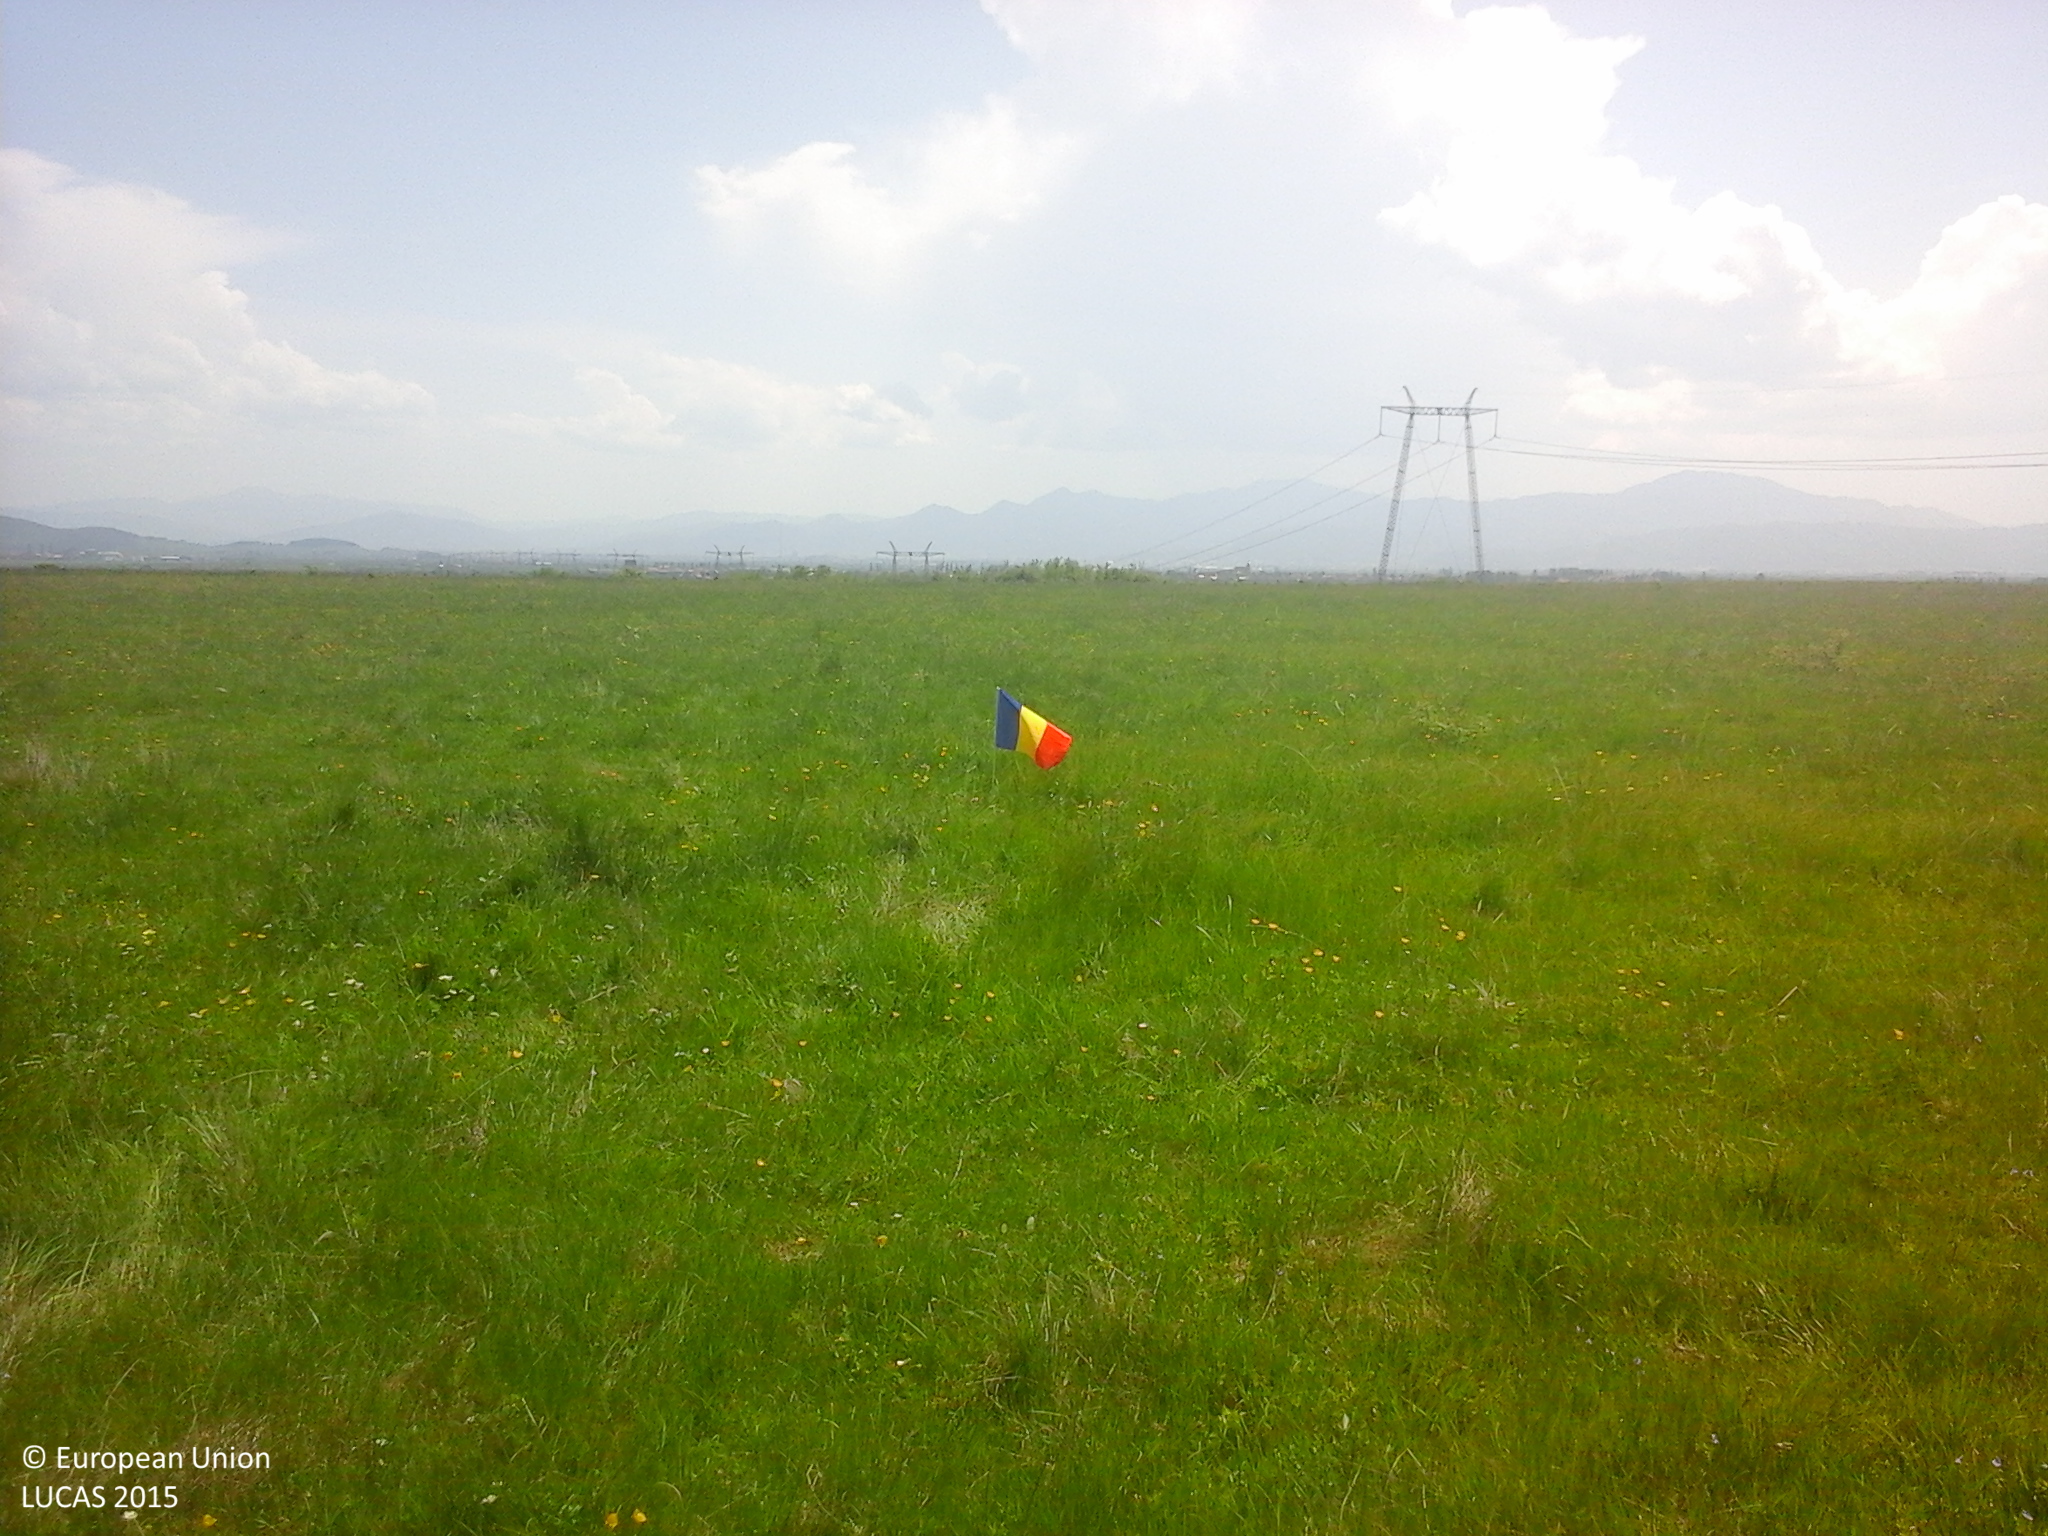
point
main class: Grassland
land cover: Grassland without tree/shrub cover
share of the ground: > 75 %
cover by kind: herbaceous plants 100 %
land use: Agriculture (excluding fallow land and kitchen gardens)
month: May
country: RO
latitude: 45.7949
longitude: 25.5291
